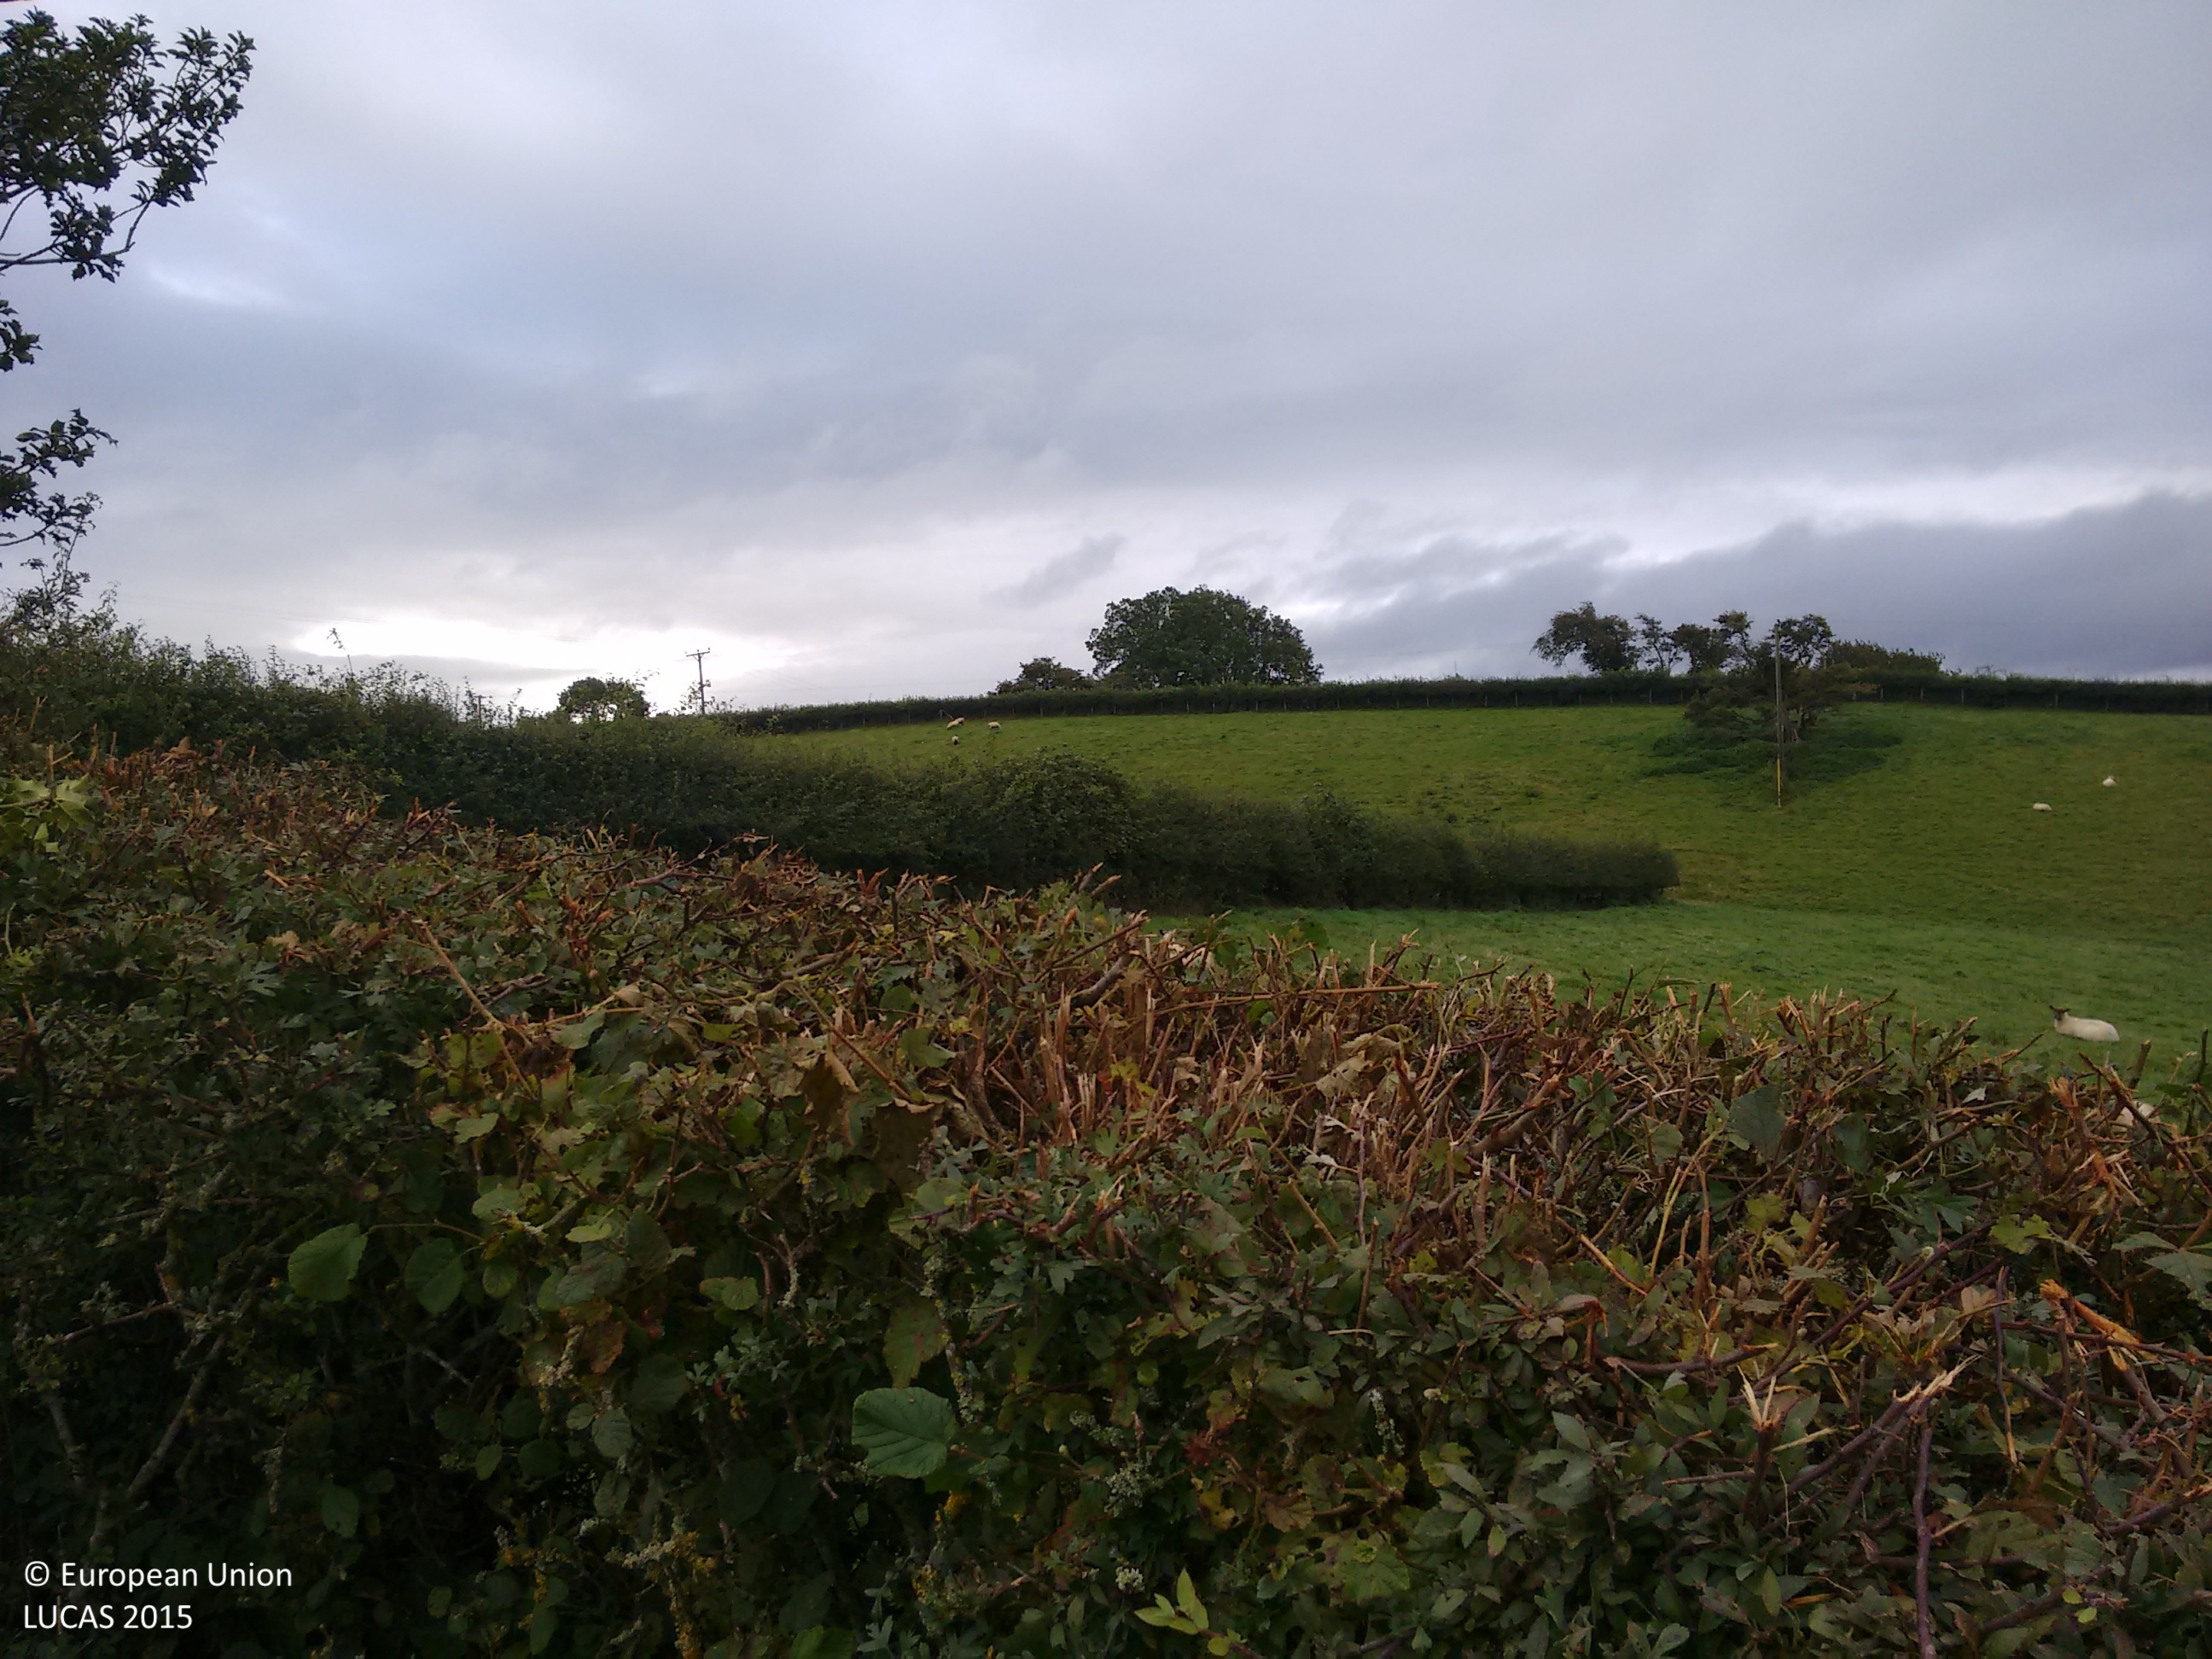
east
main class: Grassland
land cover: Grassland with sparse tree/shrub cover
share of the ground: > 75 %
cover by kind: herbaceous plants 95 %, broadleaved forest trees 5 %
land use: Agriculture (excluding fallow land and kitchen gardens)
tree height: > 5 m
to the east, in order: Grassland with sparse tree/shrub cover; Managed hedges; Tracks; Managed hedges; Grassland without tree/shrub cover; Abandoned hedges; Grassland without tree/shrub cover; Abandoned hedges; Grassland without tree/shrub cover; Managed hedges
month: September
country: GB
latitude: 52.5358
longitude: -3.3049
